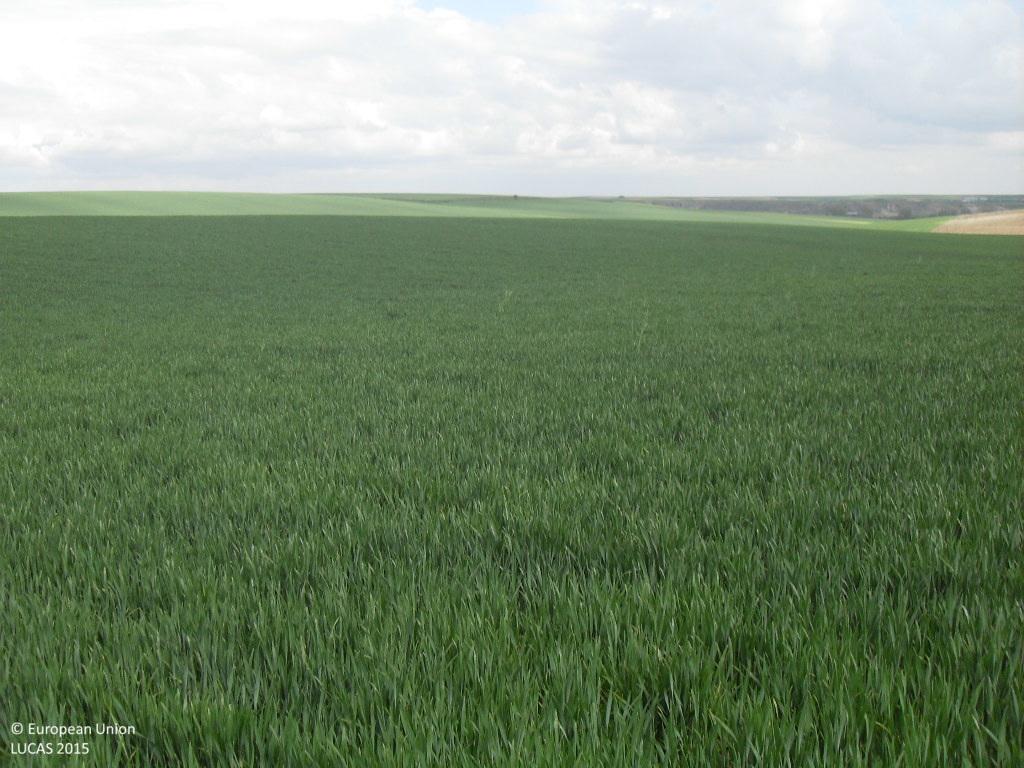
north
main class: Cropland
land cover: Common wheat
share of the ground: > 75 %
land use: Agriculture (excluding fallow land and kitchen gardens)
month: April
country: ES
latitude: 40.8009
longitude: -5.3231
